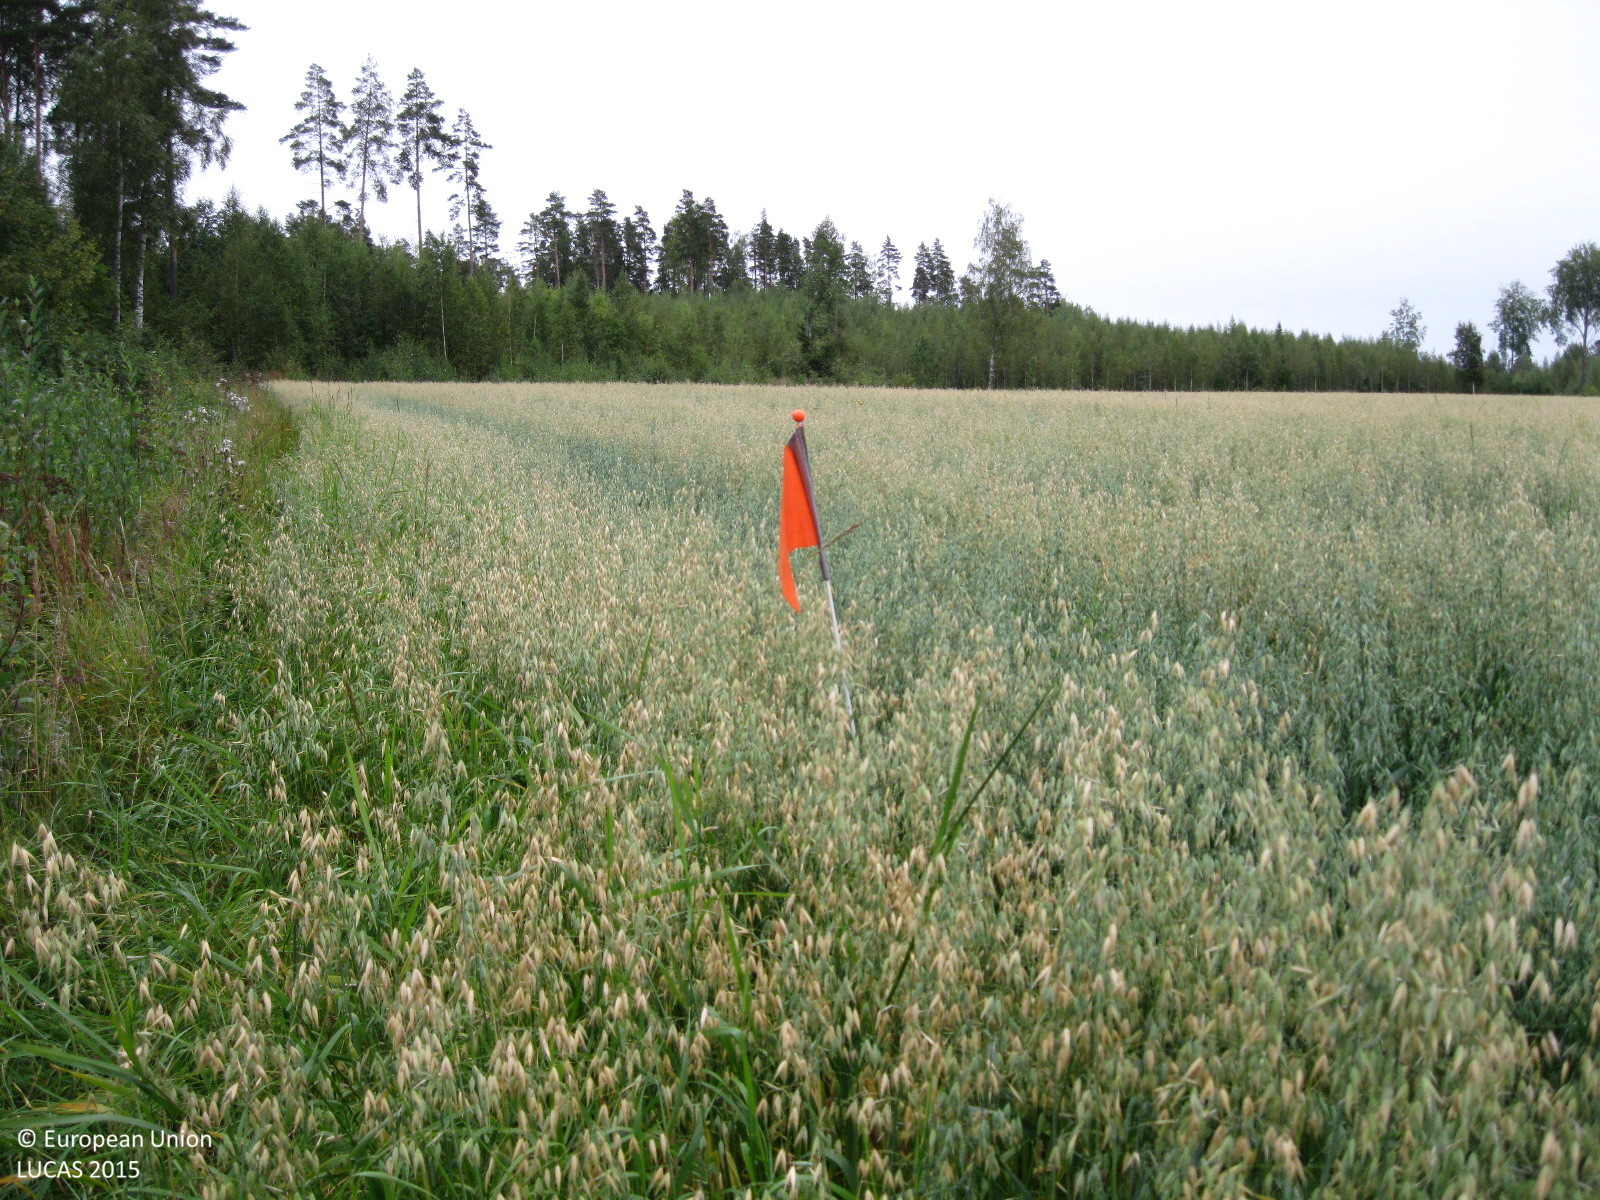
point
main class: Cropland
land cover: Oats
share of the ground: > 75 %
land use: Agriculture (excluding fallow land and kitchen gardens)
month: September
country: FI
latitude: 60.7822
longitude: 25.0473
